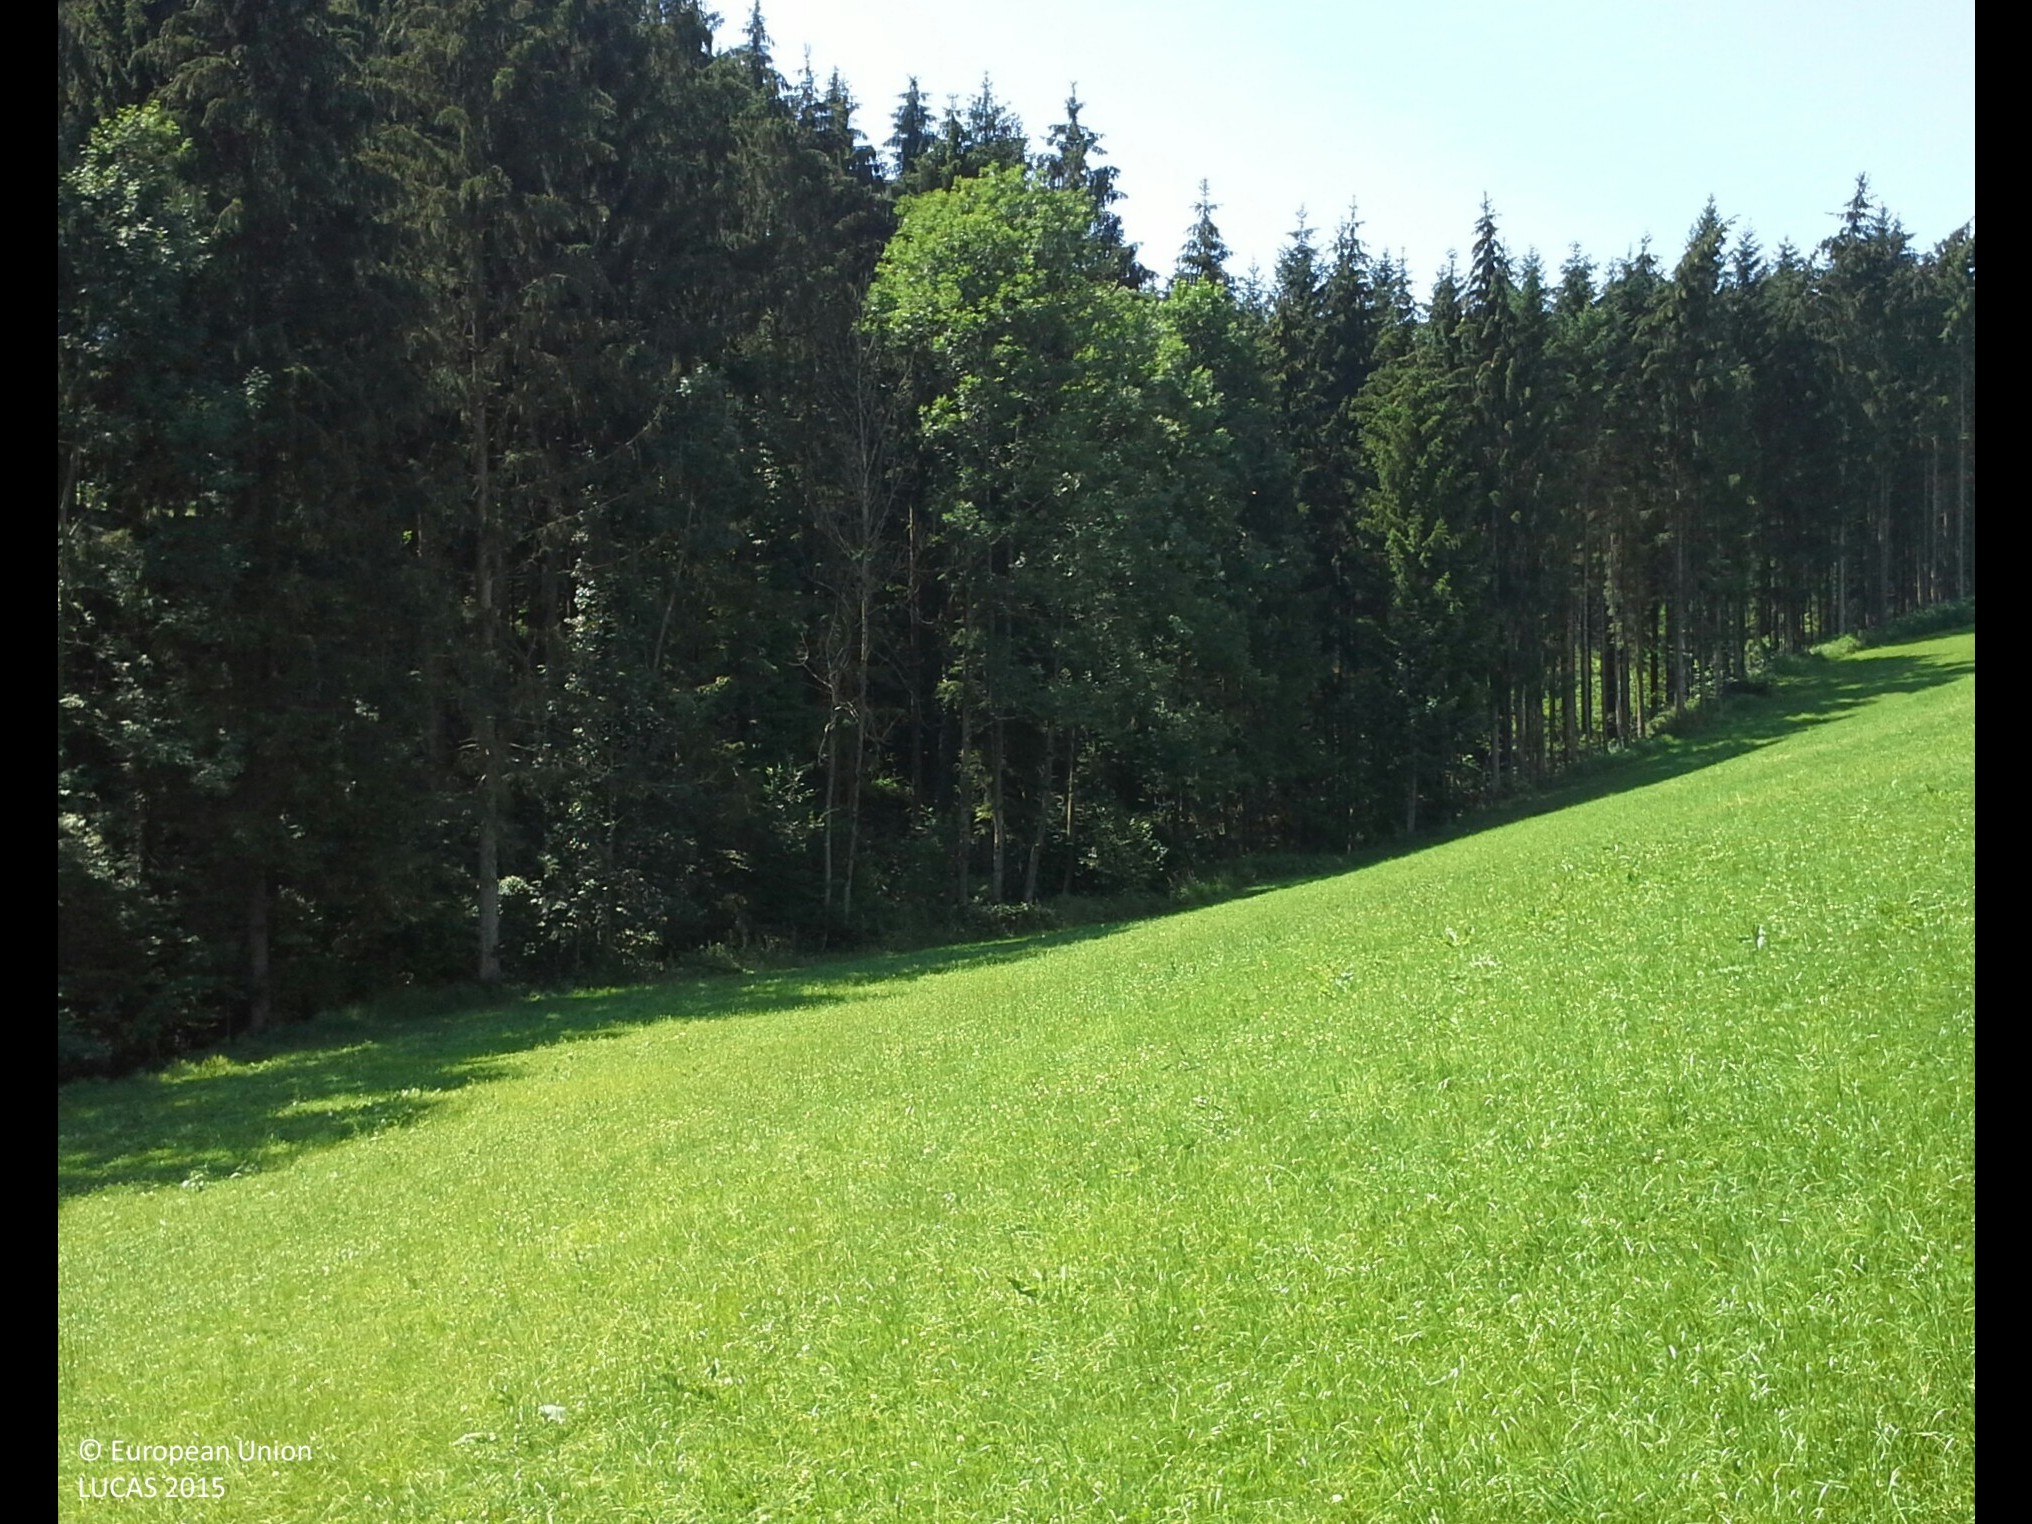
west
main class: Grassland
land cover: Grassland without tree/shrub cover
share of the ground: > 75 %
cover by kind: herbaceous plants 100 %
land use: Agriculture (excluding fallow land and kitchen gardens)
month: July
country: AT
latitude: 47.9790
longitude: 14.7027
